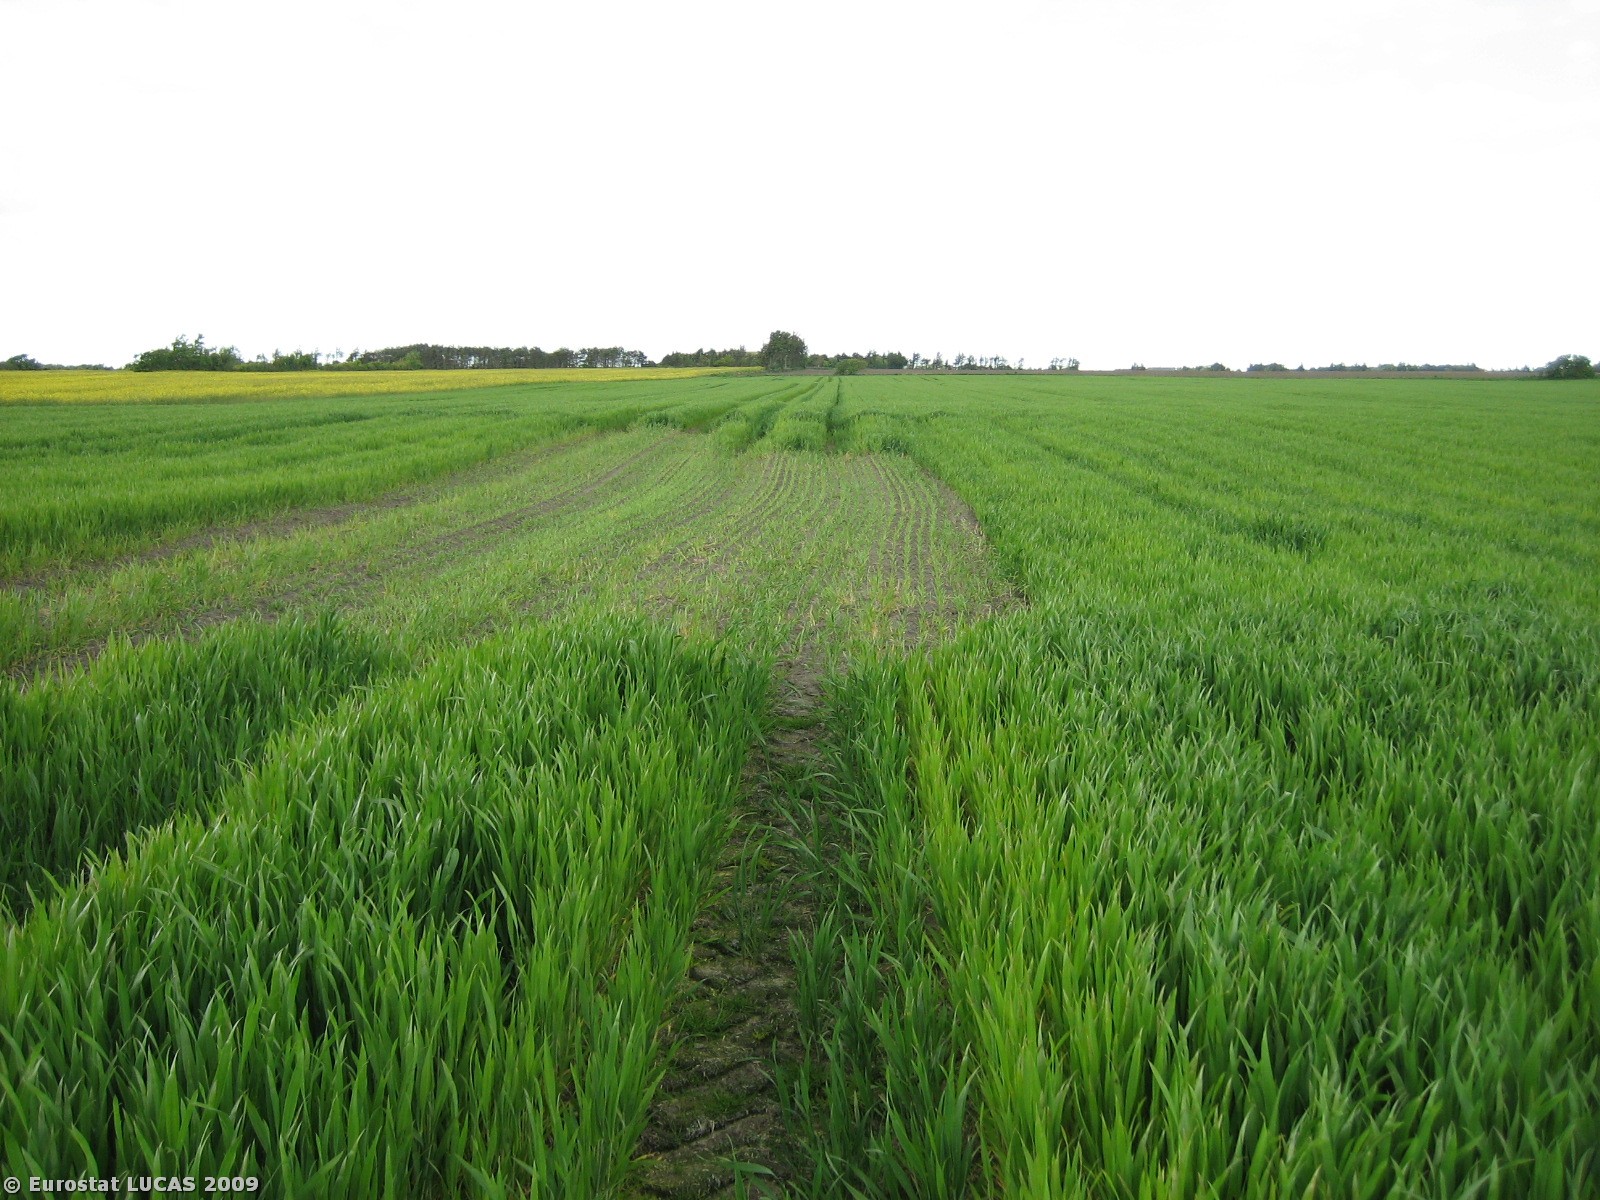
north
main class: Cropland
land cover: Common wheat
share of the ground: > 75 %
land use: Agriculture (excluding fallow land and kitchen gardens)
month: May
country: DK
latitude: 56.2113
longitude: 8.2123
